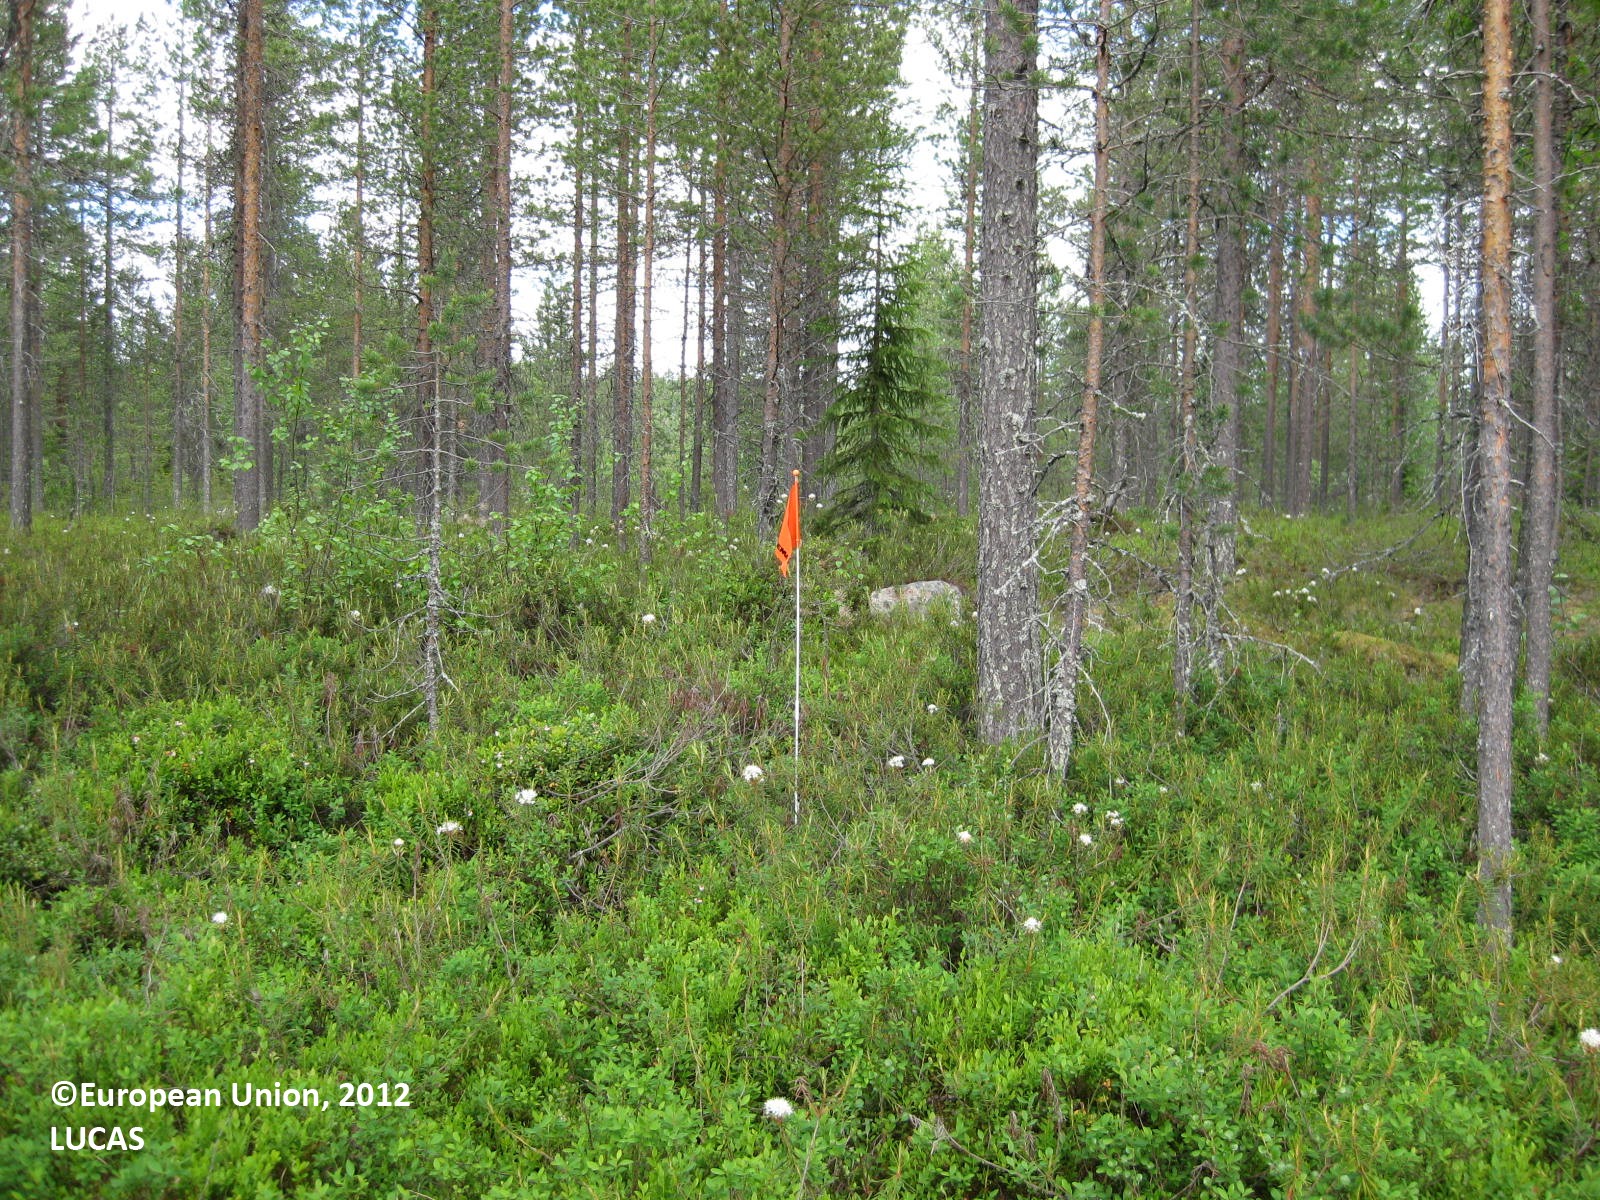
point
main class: Woodland
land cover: Pine dominated coniferous woodland
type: boreal forest
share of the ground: 50 - 75 %
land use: Forestry
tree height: > 5 m
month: July
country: FI
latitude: 65.4608
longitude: 29.1535
